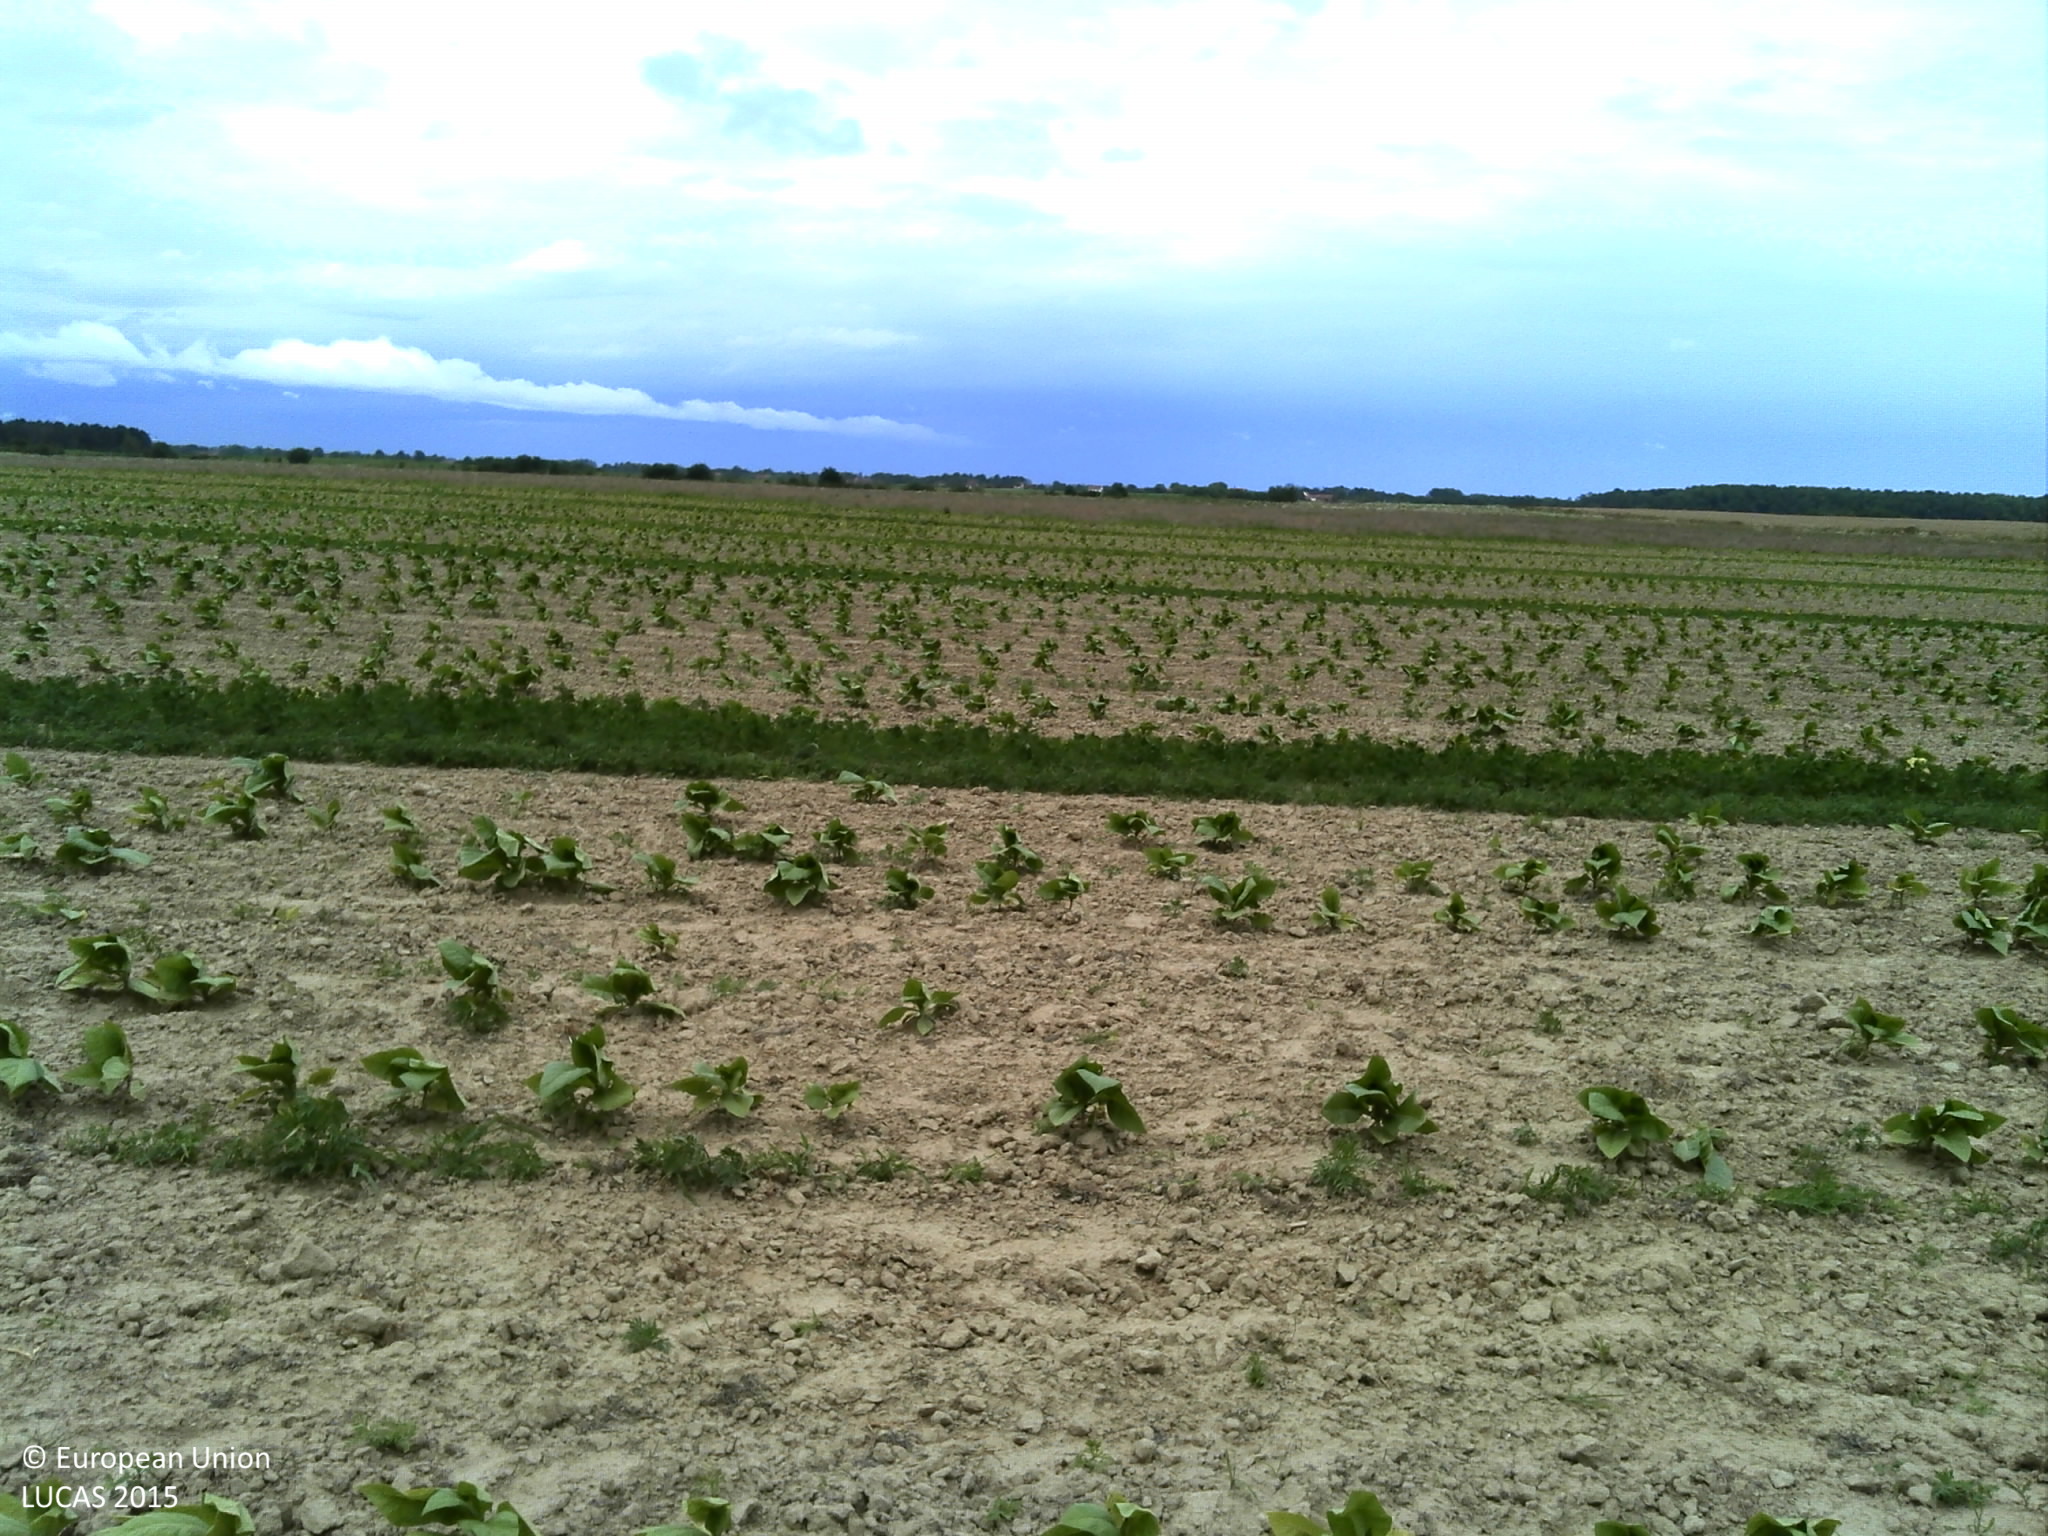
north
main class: Cropland
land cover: Tobacco
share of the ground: 10 - 25 %
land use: Agriculture (excluding fallow land and kitchen gardens)
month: June
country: HR
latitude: 45.8141
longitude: 17.5314
